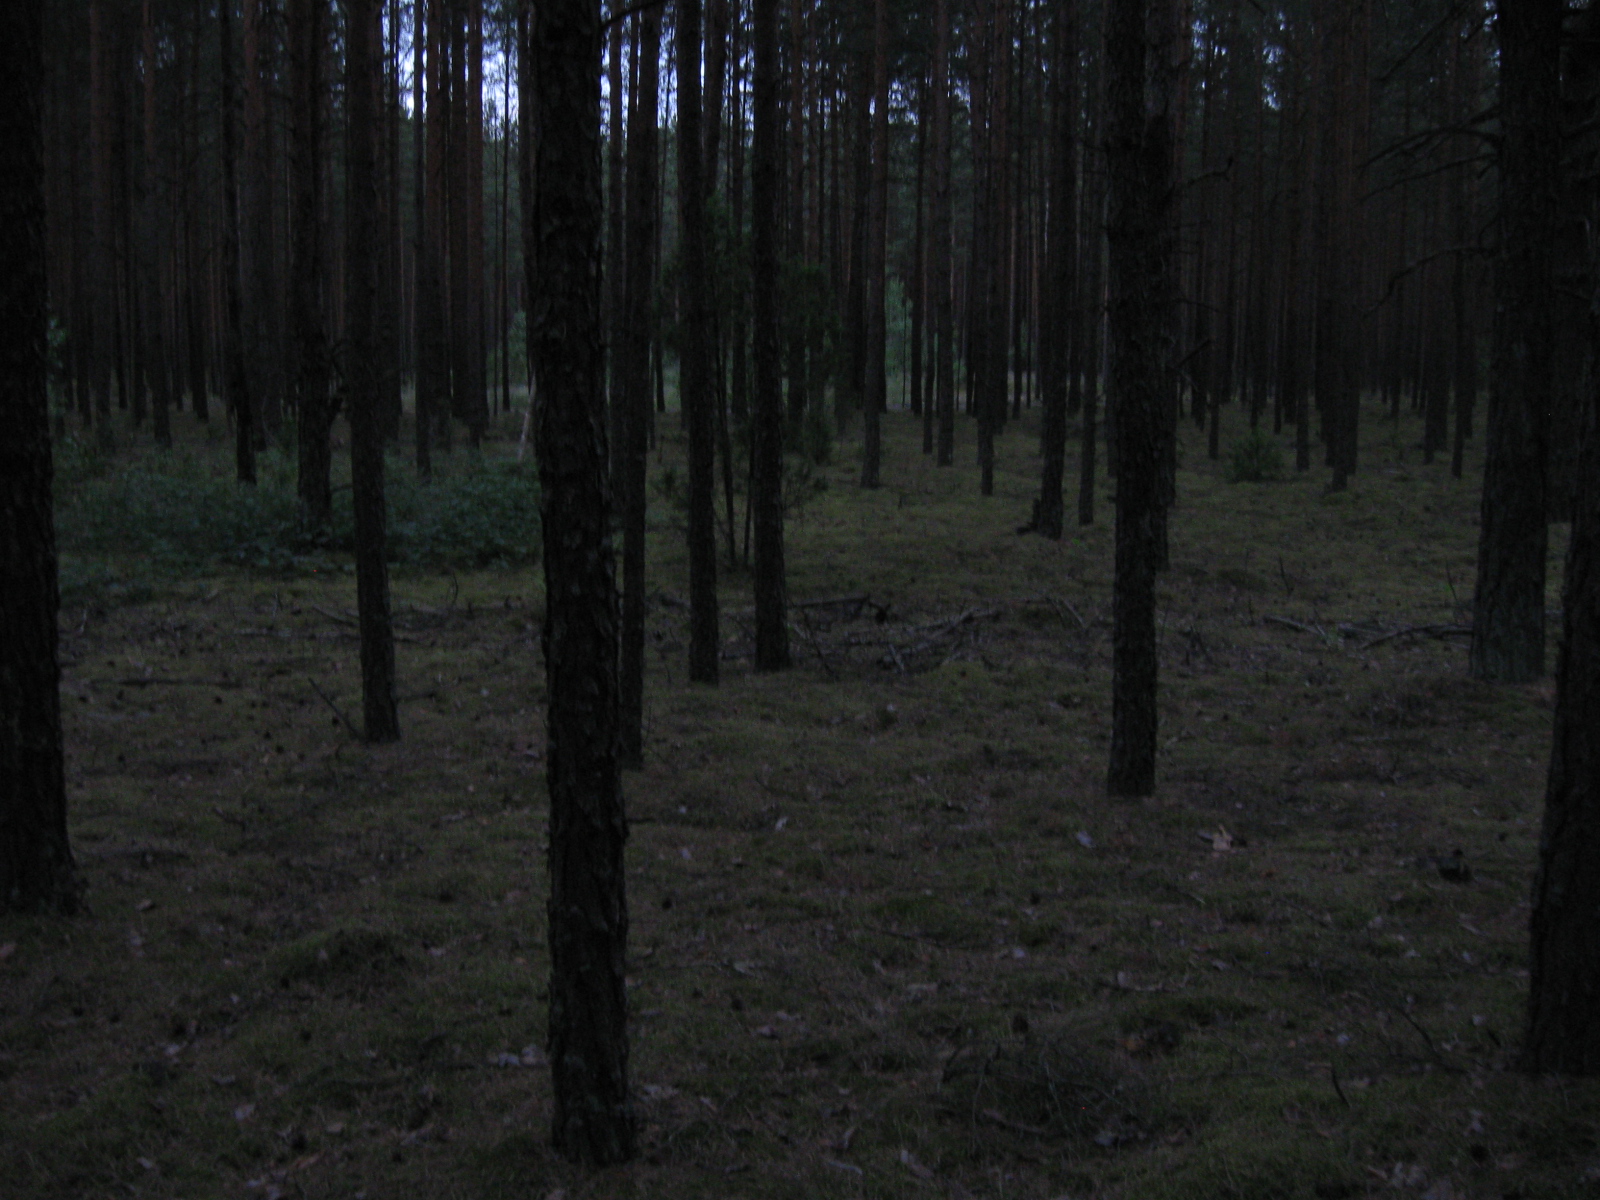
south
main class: Woodland
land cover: Pine dominated coniferous woodland
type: hemiboreal forest and nemoral coniferous forest and mixed broadleaved-coniferous forest
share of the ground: > 75 %
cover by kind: coniferous forest trees 90 %, lichens and mosses 10 %
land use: Forestry
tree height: > 5 m
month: June
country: LT
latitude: 54.1283
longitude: 24.2220
